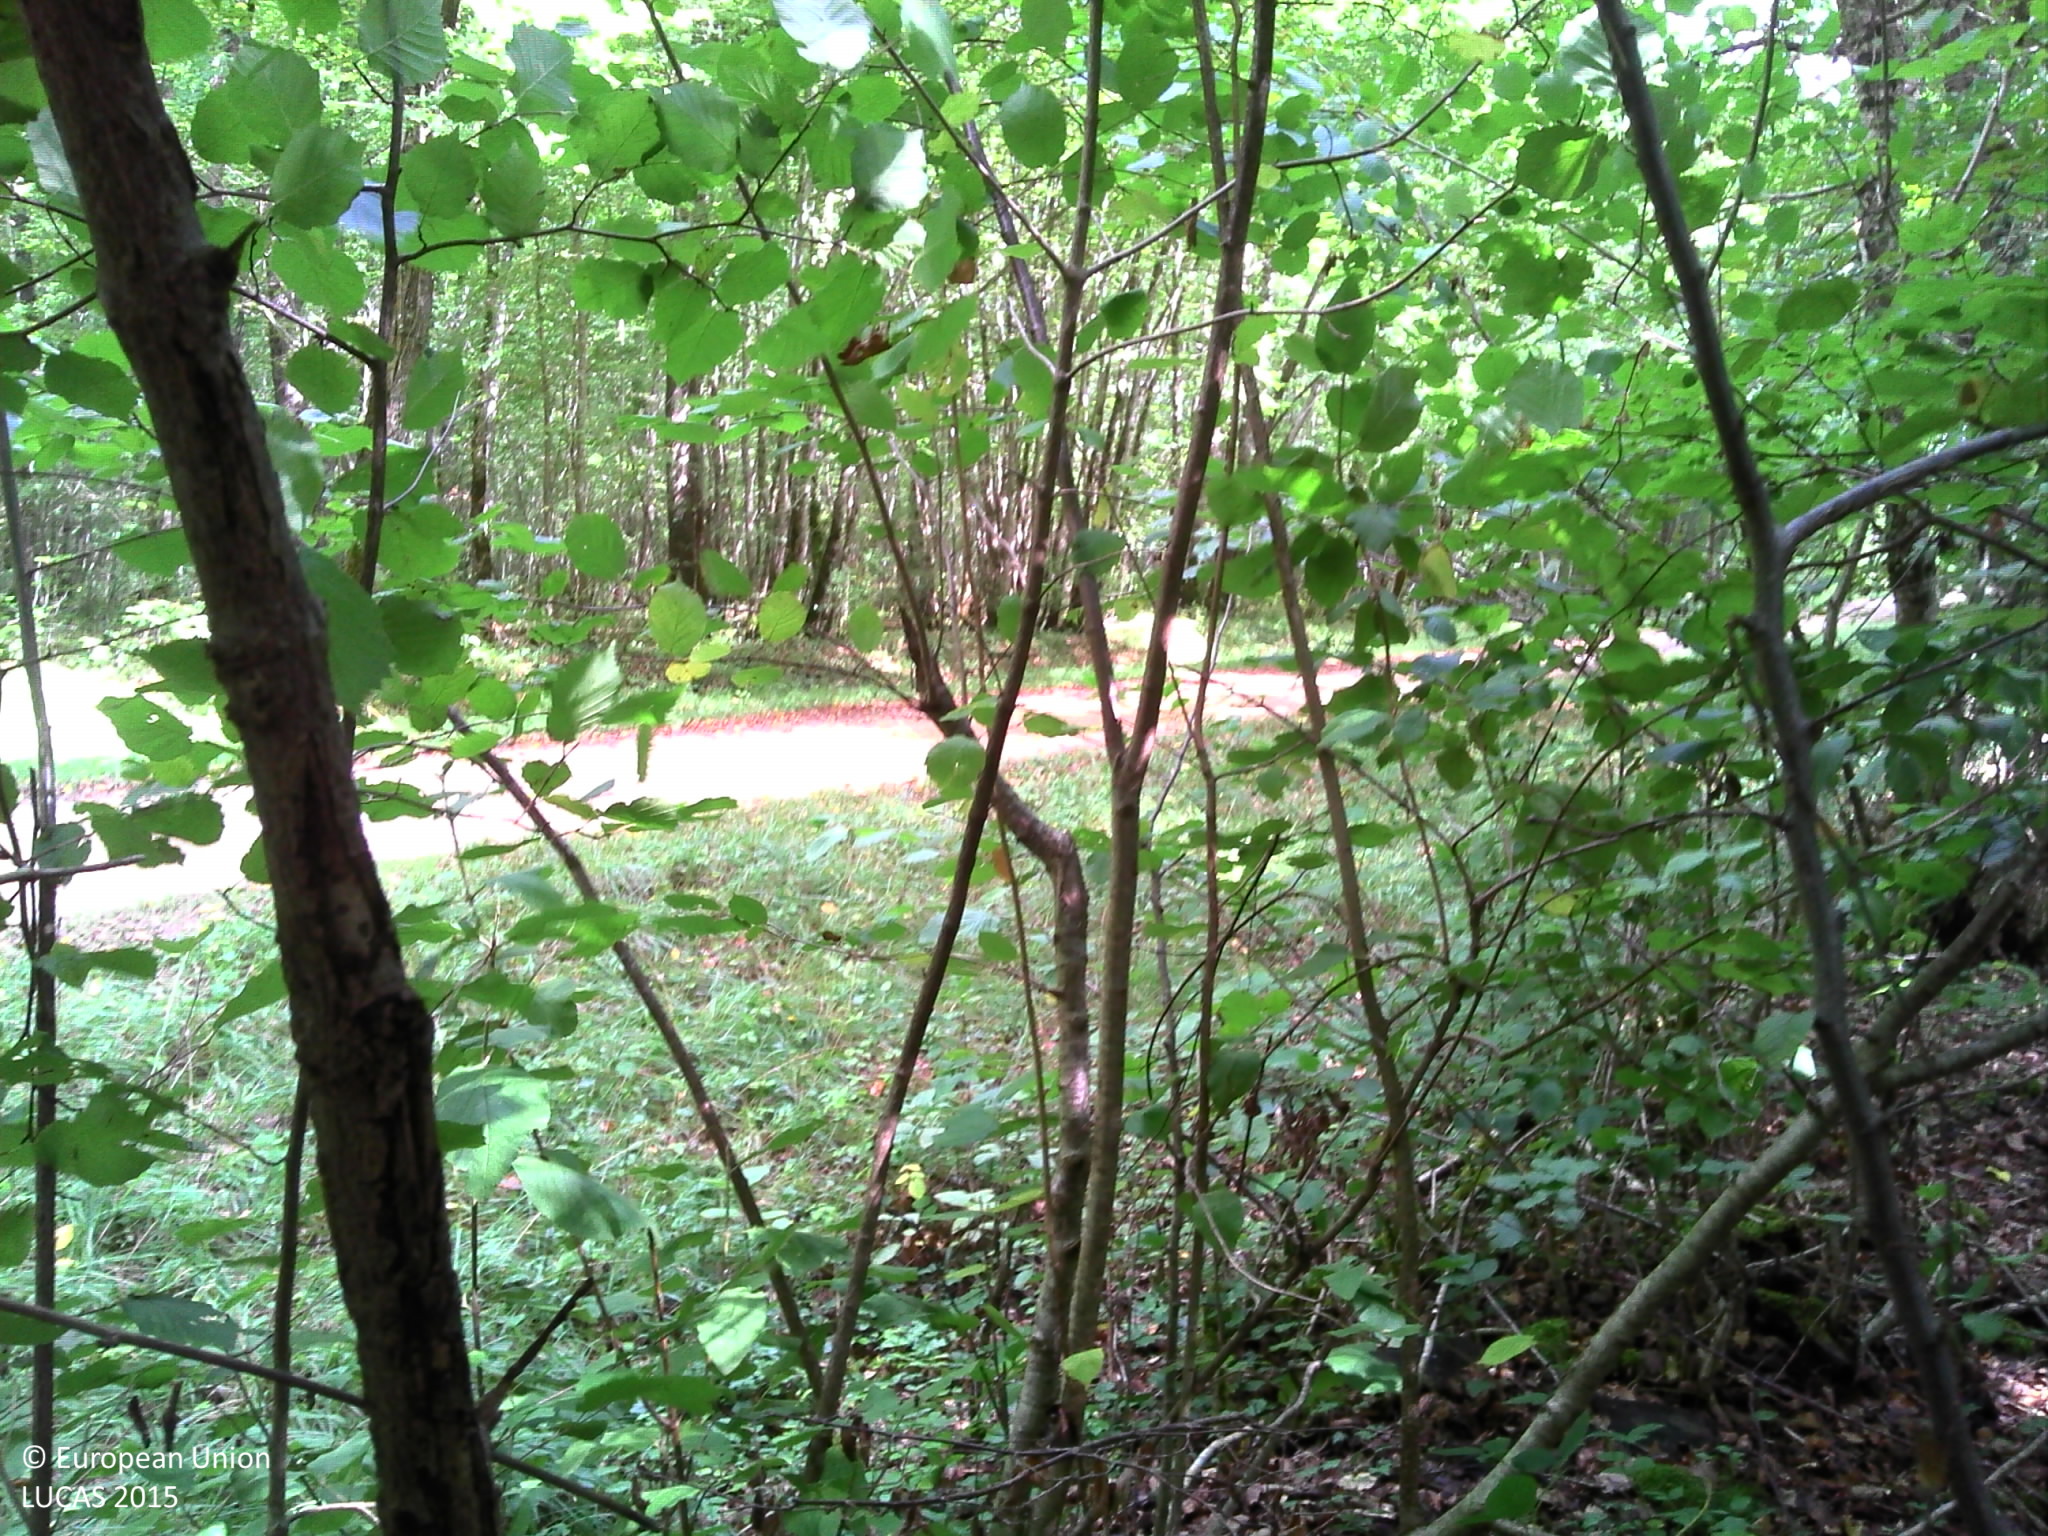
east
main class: Woodland
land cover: Broadleaved woodland
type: mesophytic deciduous forest
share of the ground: > 75 %
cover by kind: broadleaved forest trees 85 %, shrubs 5 %, herbaceous plants 5 %, lichens and mosses 5 %
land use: Forestry
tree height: > 5 m
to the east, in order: Broadleaved woodland; Ditches and canals; Grass margins; Tracks; Grass margins; Ditches and canals; Broadleaved woodland; Tracks; Broadleaved woodland
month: August
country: FR
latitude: 47.9035
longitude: 4.8218
